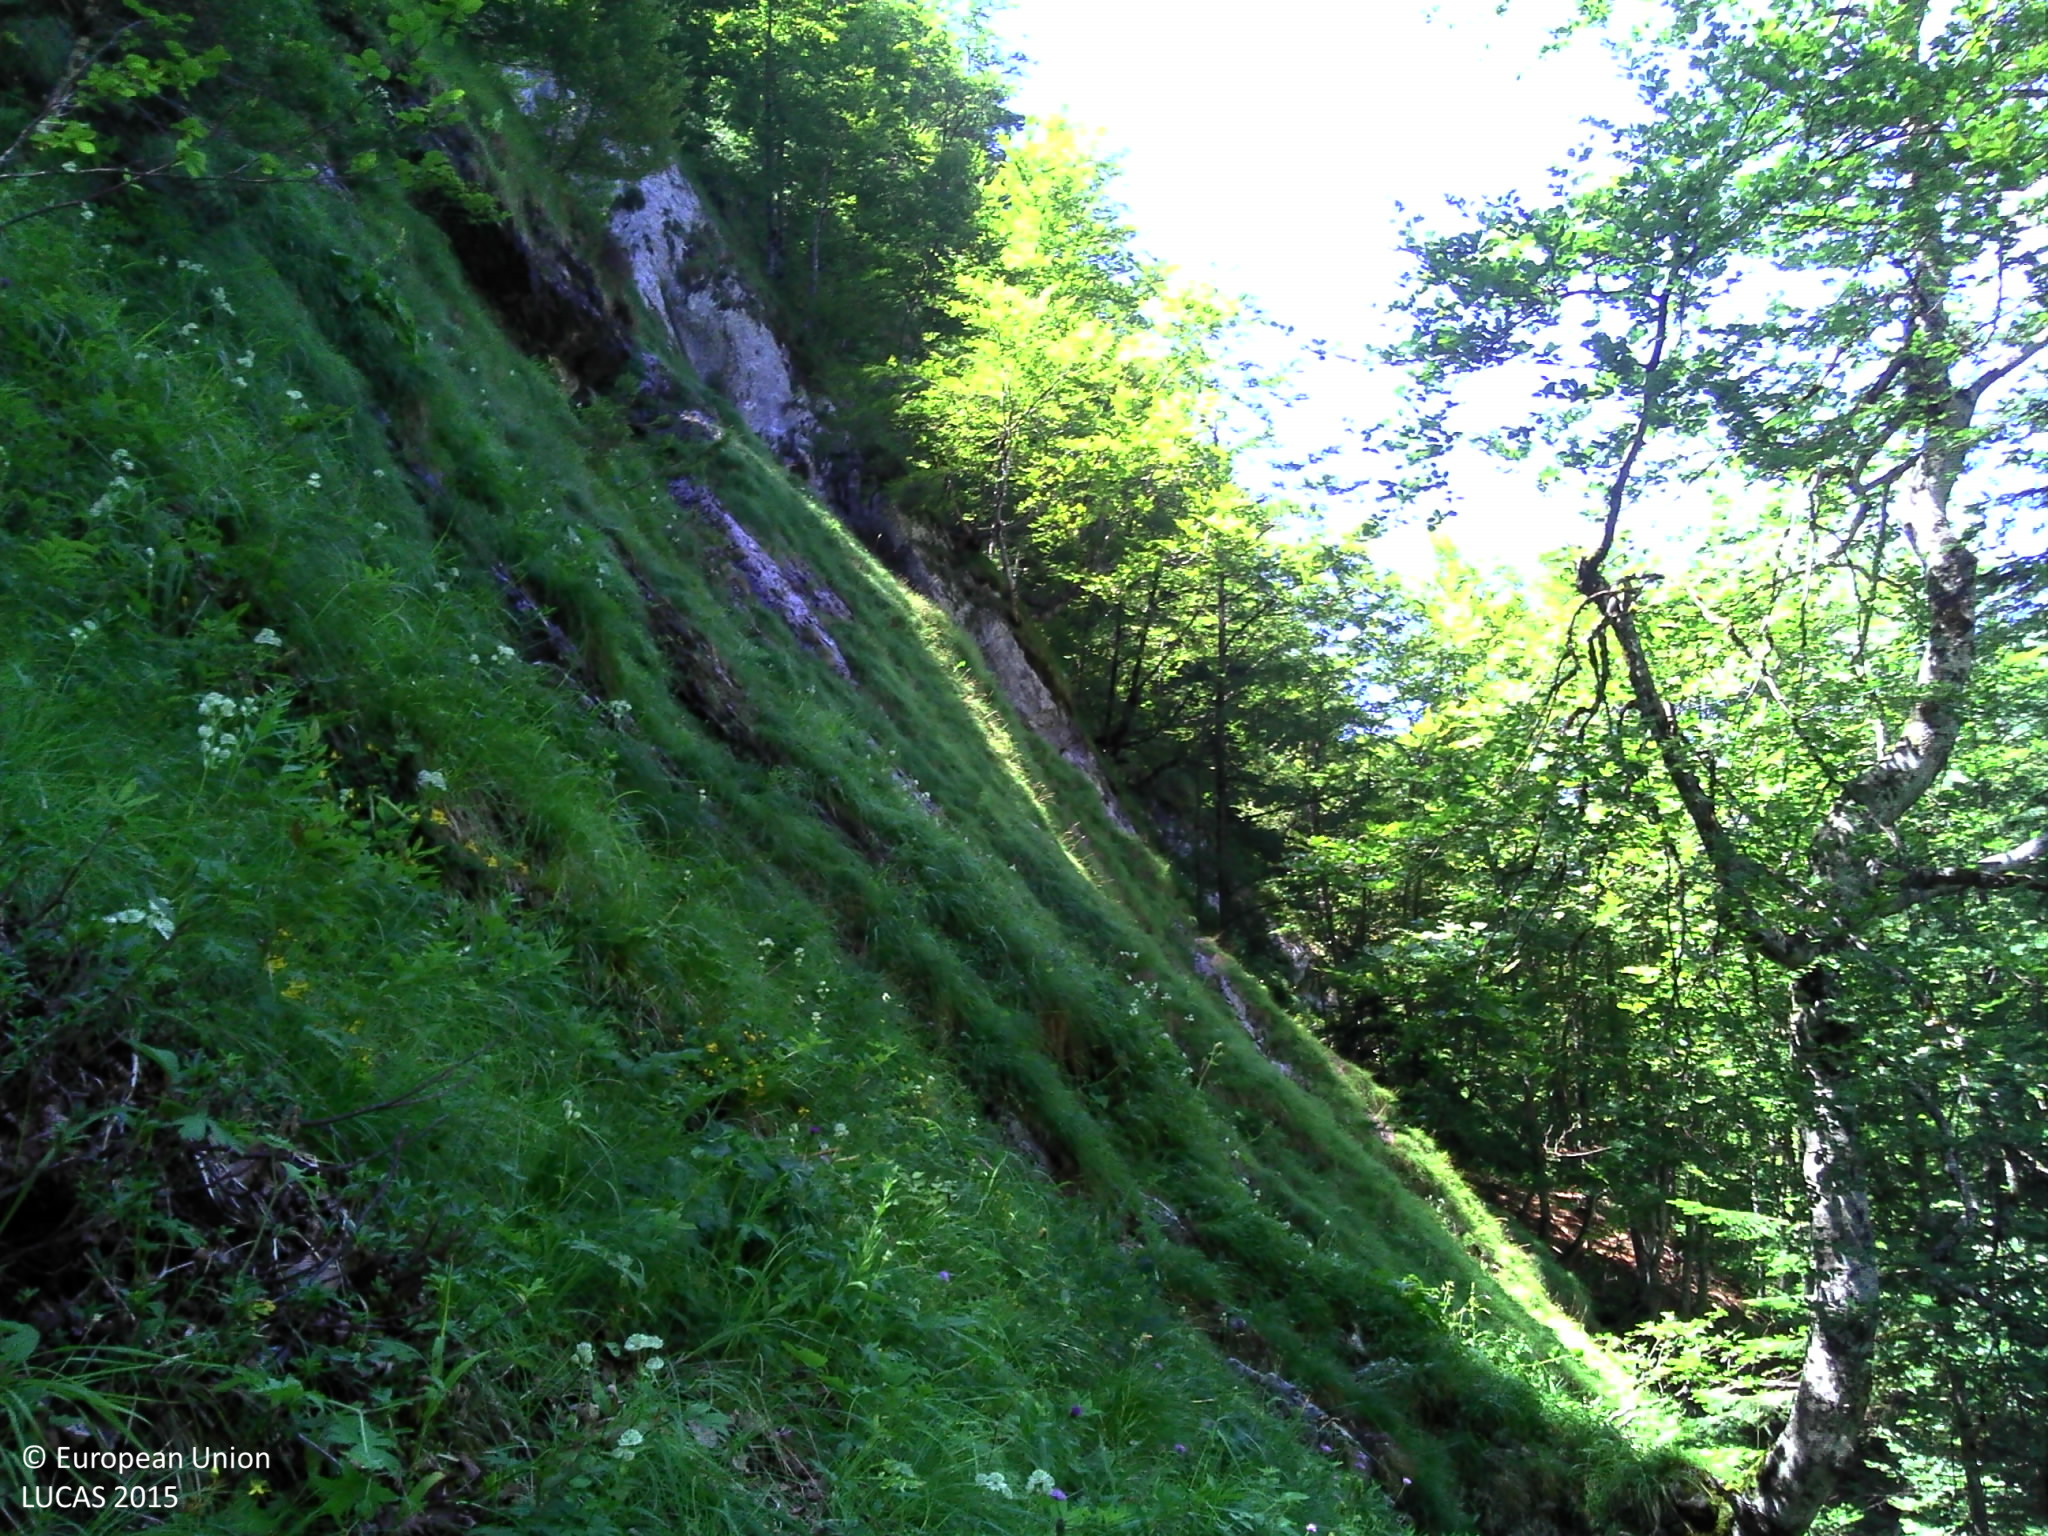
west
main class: Woodland
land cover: Spruce dominated mixed woodland
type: mountainous beech forest
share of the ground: > 75 %
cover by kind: broadleaved forest trees 55 %, coniferous forest trees 25 %, herbaceous plants 10 %, lichens and mosses 10 %
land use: Forestry
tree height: > 5 m
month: July
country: FR
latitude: 42.9603
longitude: -0.3383
